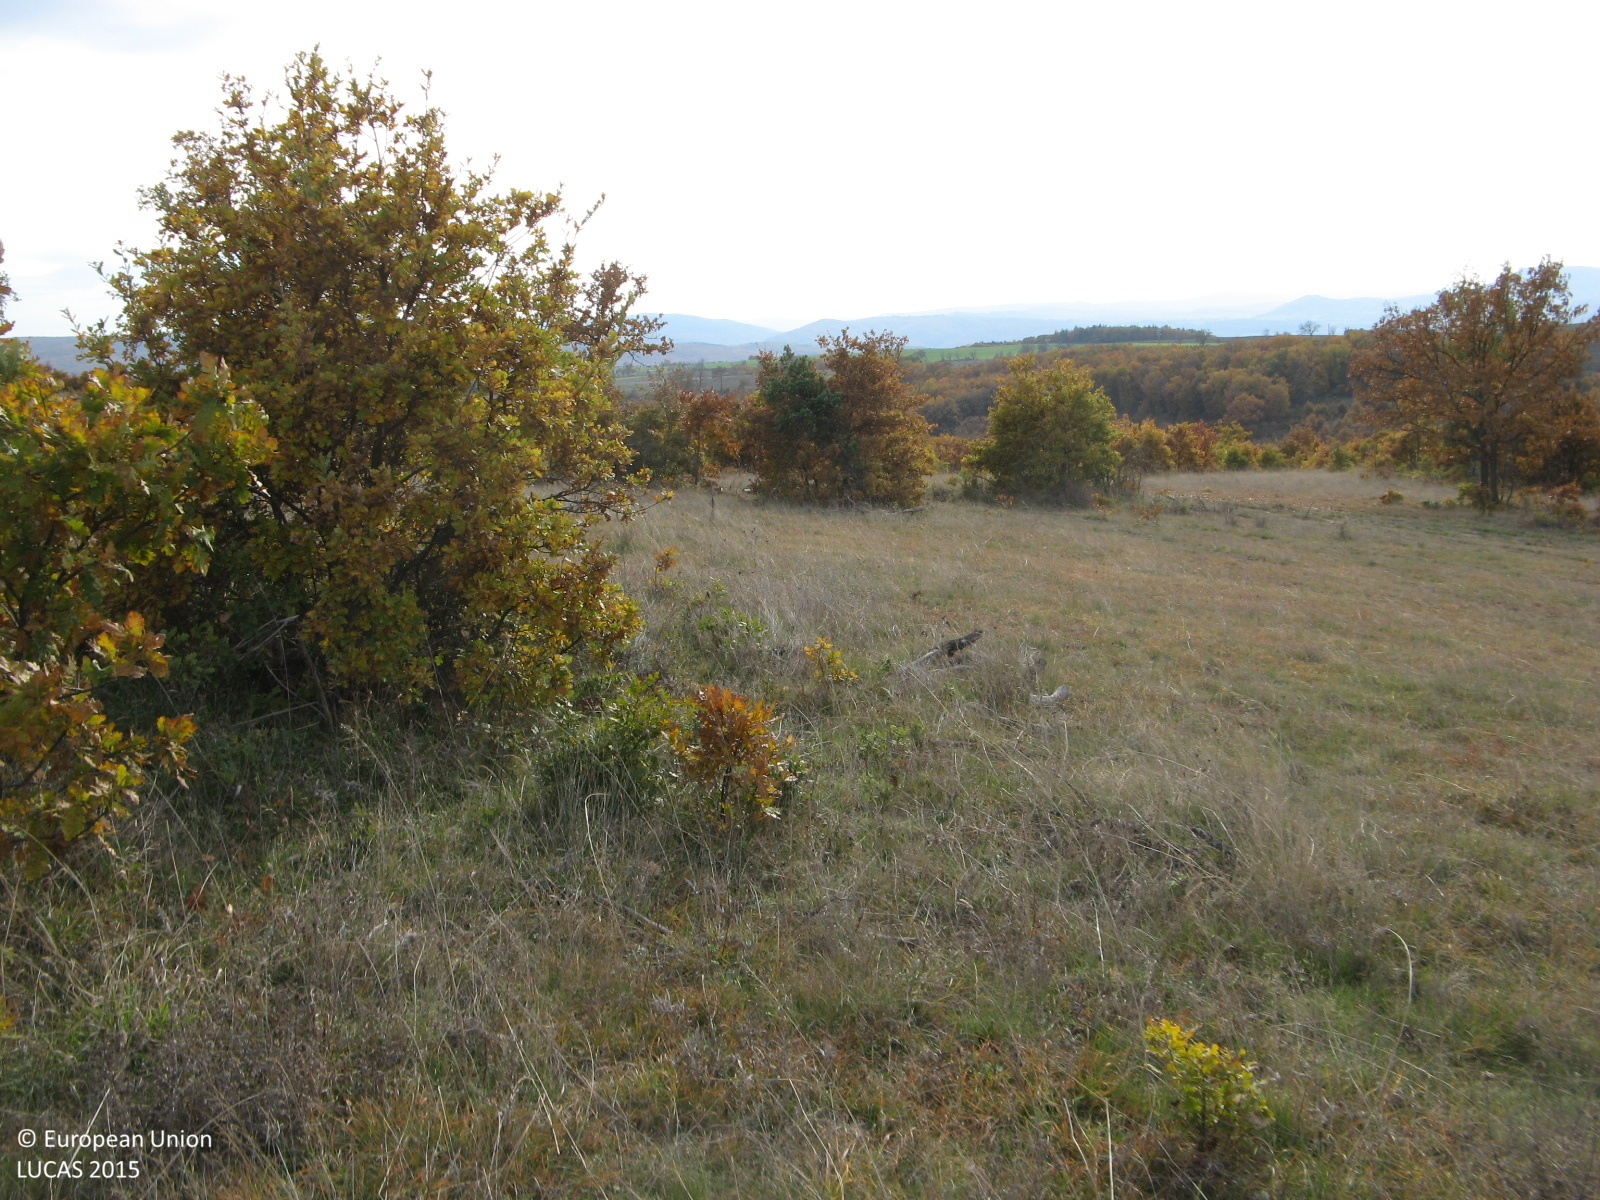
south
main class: Grassland
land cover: Grassland with sparse tree/shrub cover
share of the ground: > 75 %
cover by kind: herbaceous plants 90 %, broadleaved forest trees 5 %, shrubs 5 %
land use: Agriculture (excluding fallow land and kitchen gardens)
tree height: < 5 m
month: November
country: BG
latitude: 41.6867
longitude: 25.9886
